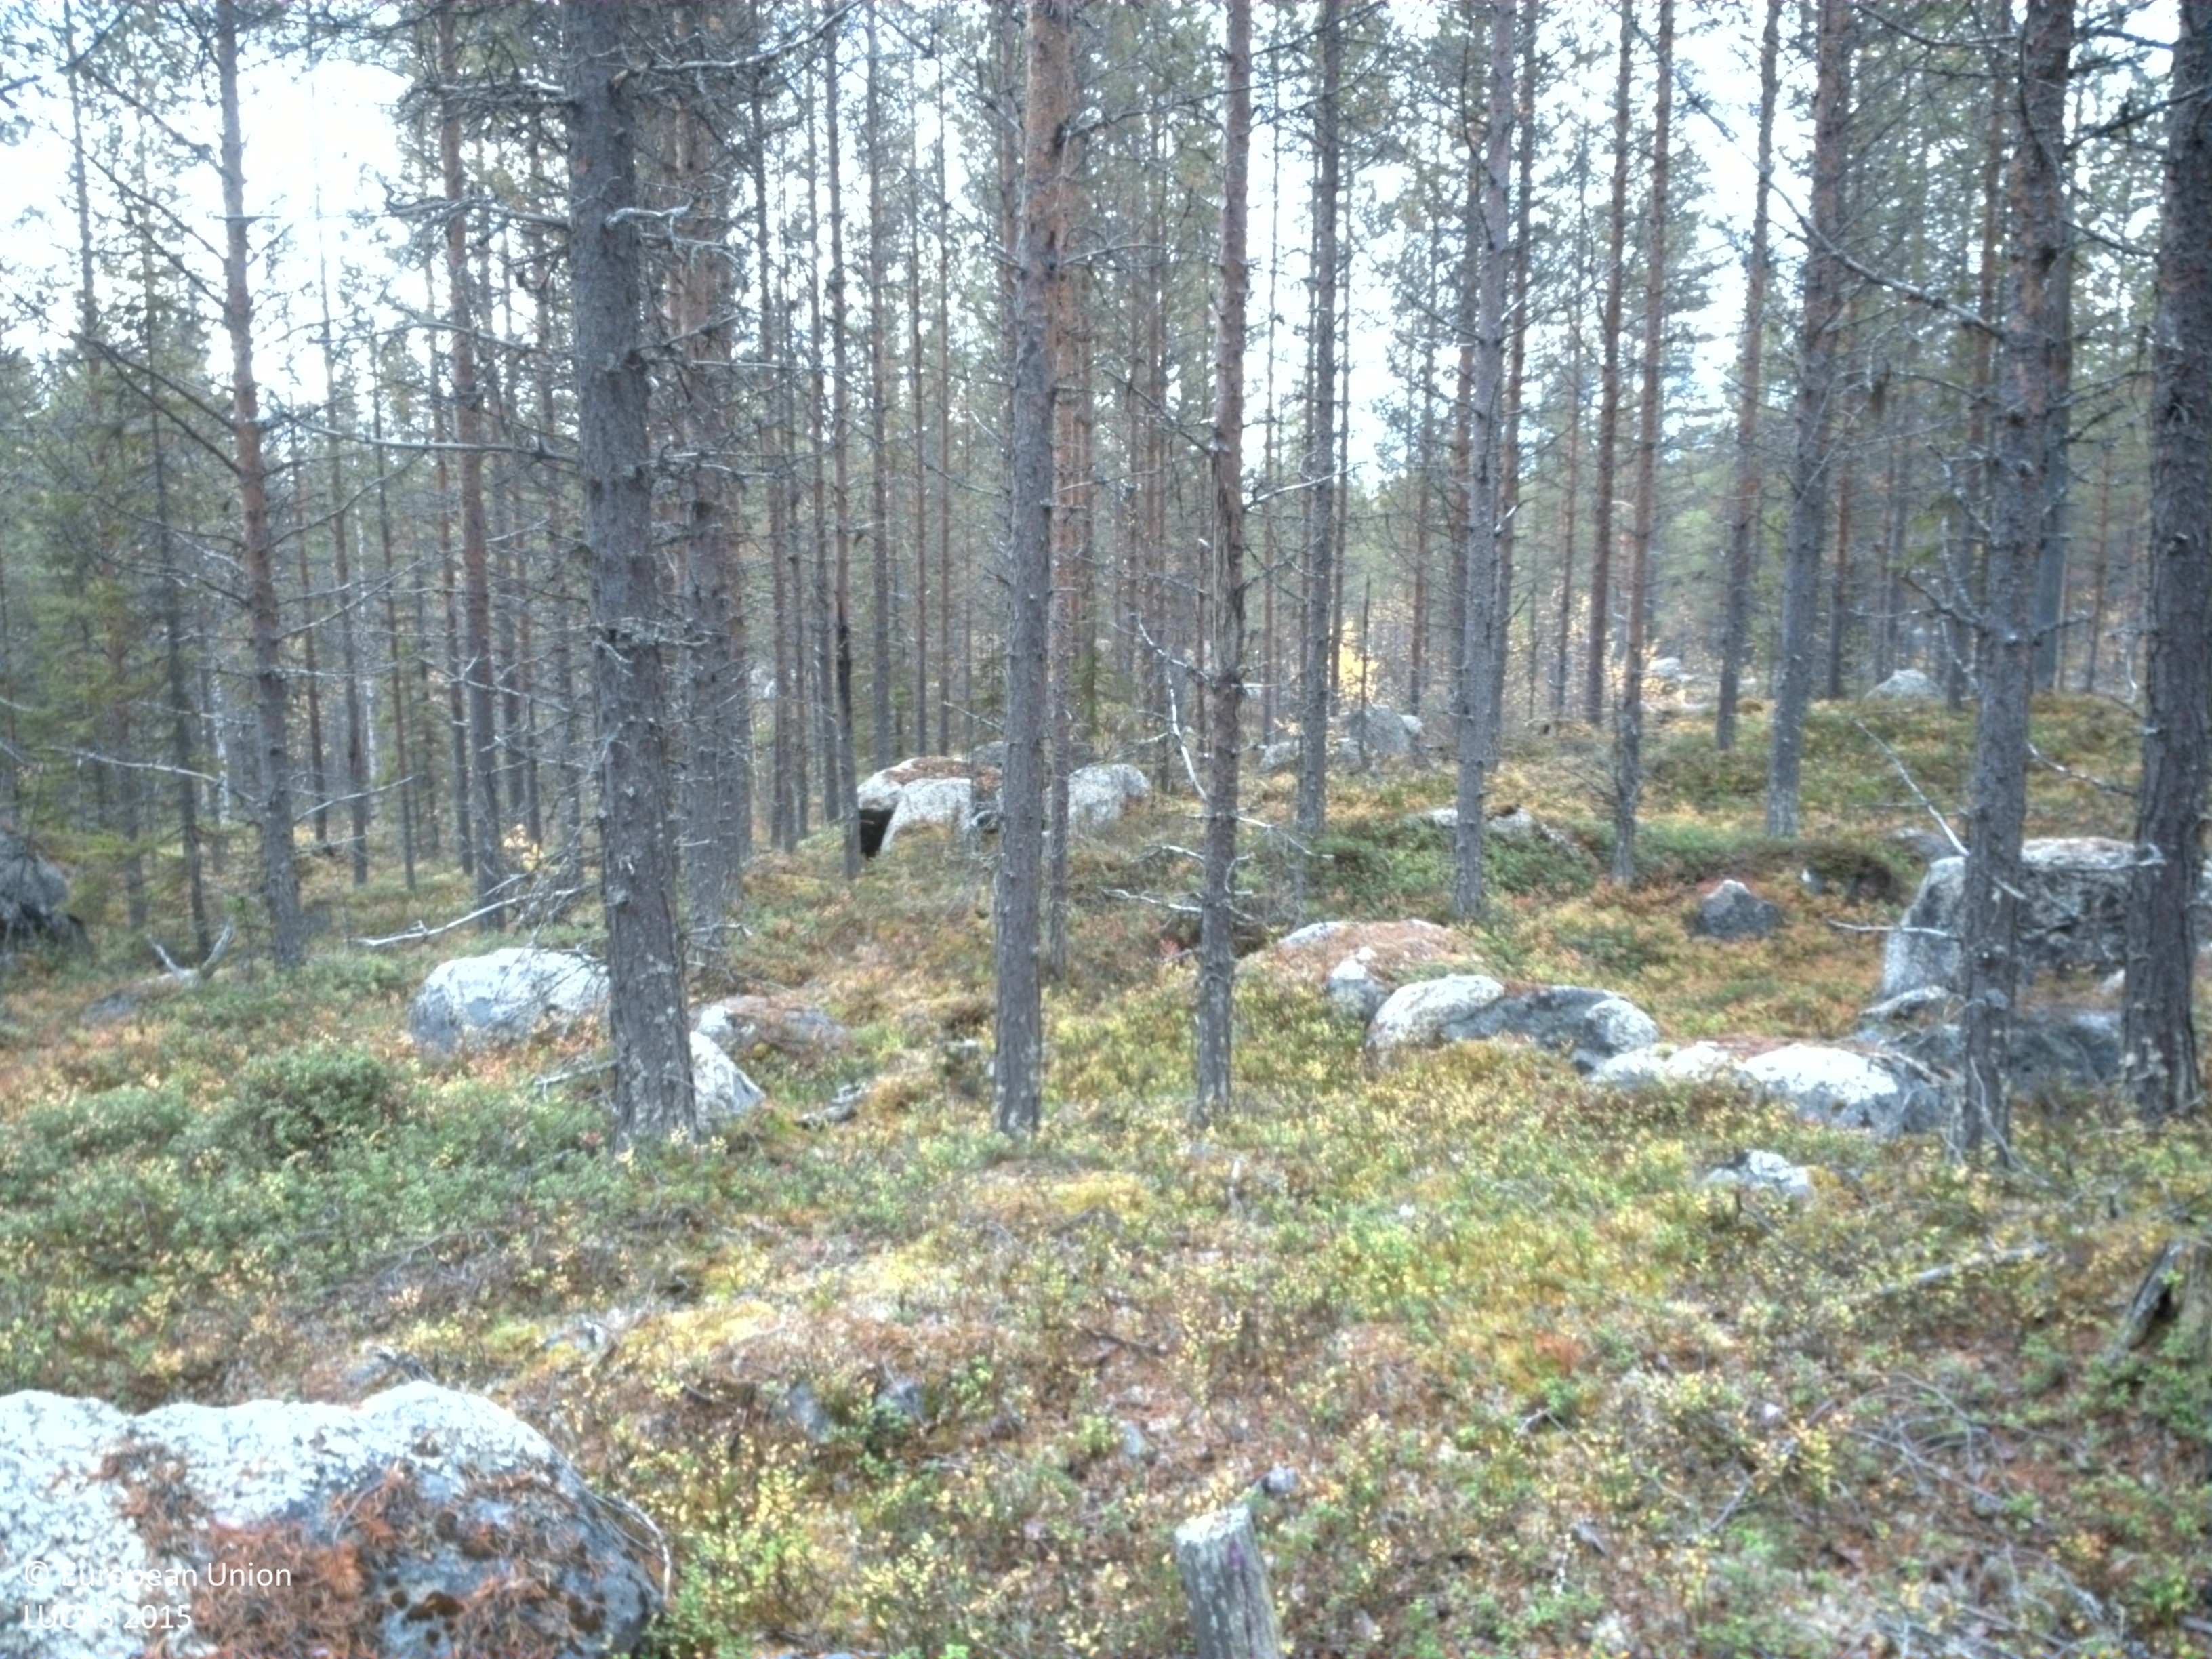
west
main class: Woodland
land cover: Pine dominated coniferous woodland
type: boreal forest
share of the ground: 25 - 50 %
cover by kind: shrubs 35 %, coniferous forest trees 30 %, lichens and mosses 30 %, consolidated bare surface 5 %
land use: Forestry
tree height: > 5 m
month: September
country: SE
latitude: 65.0597
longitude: 17.8059
